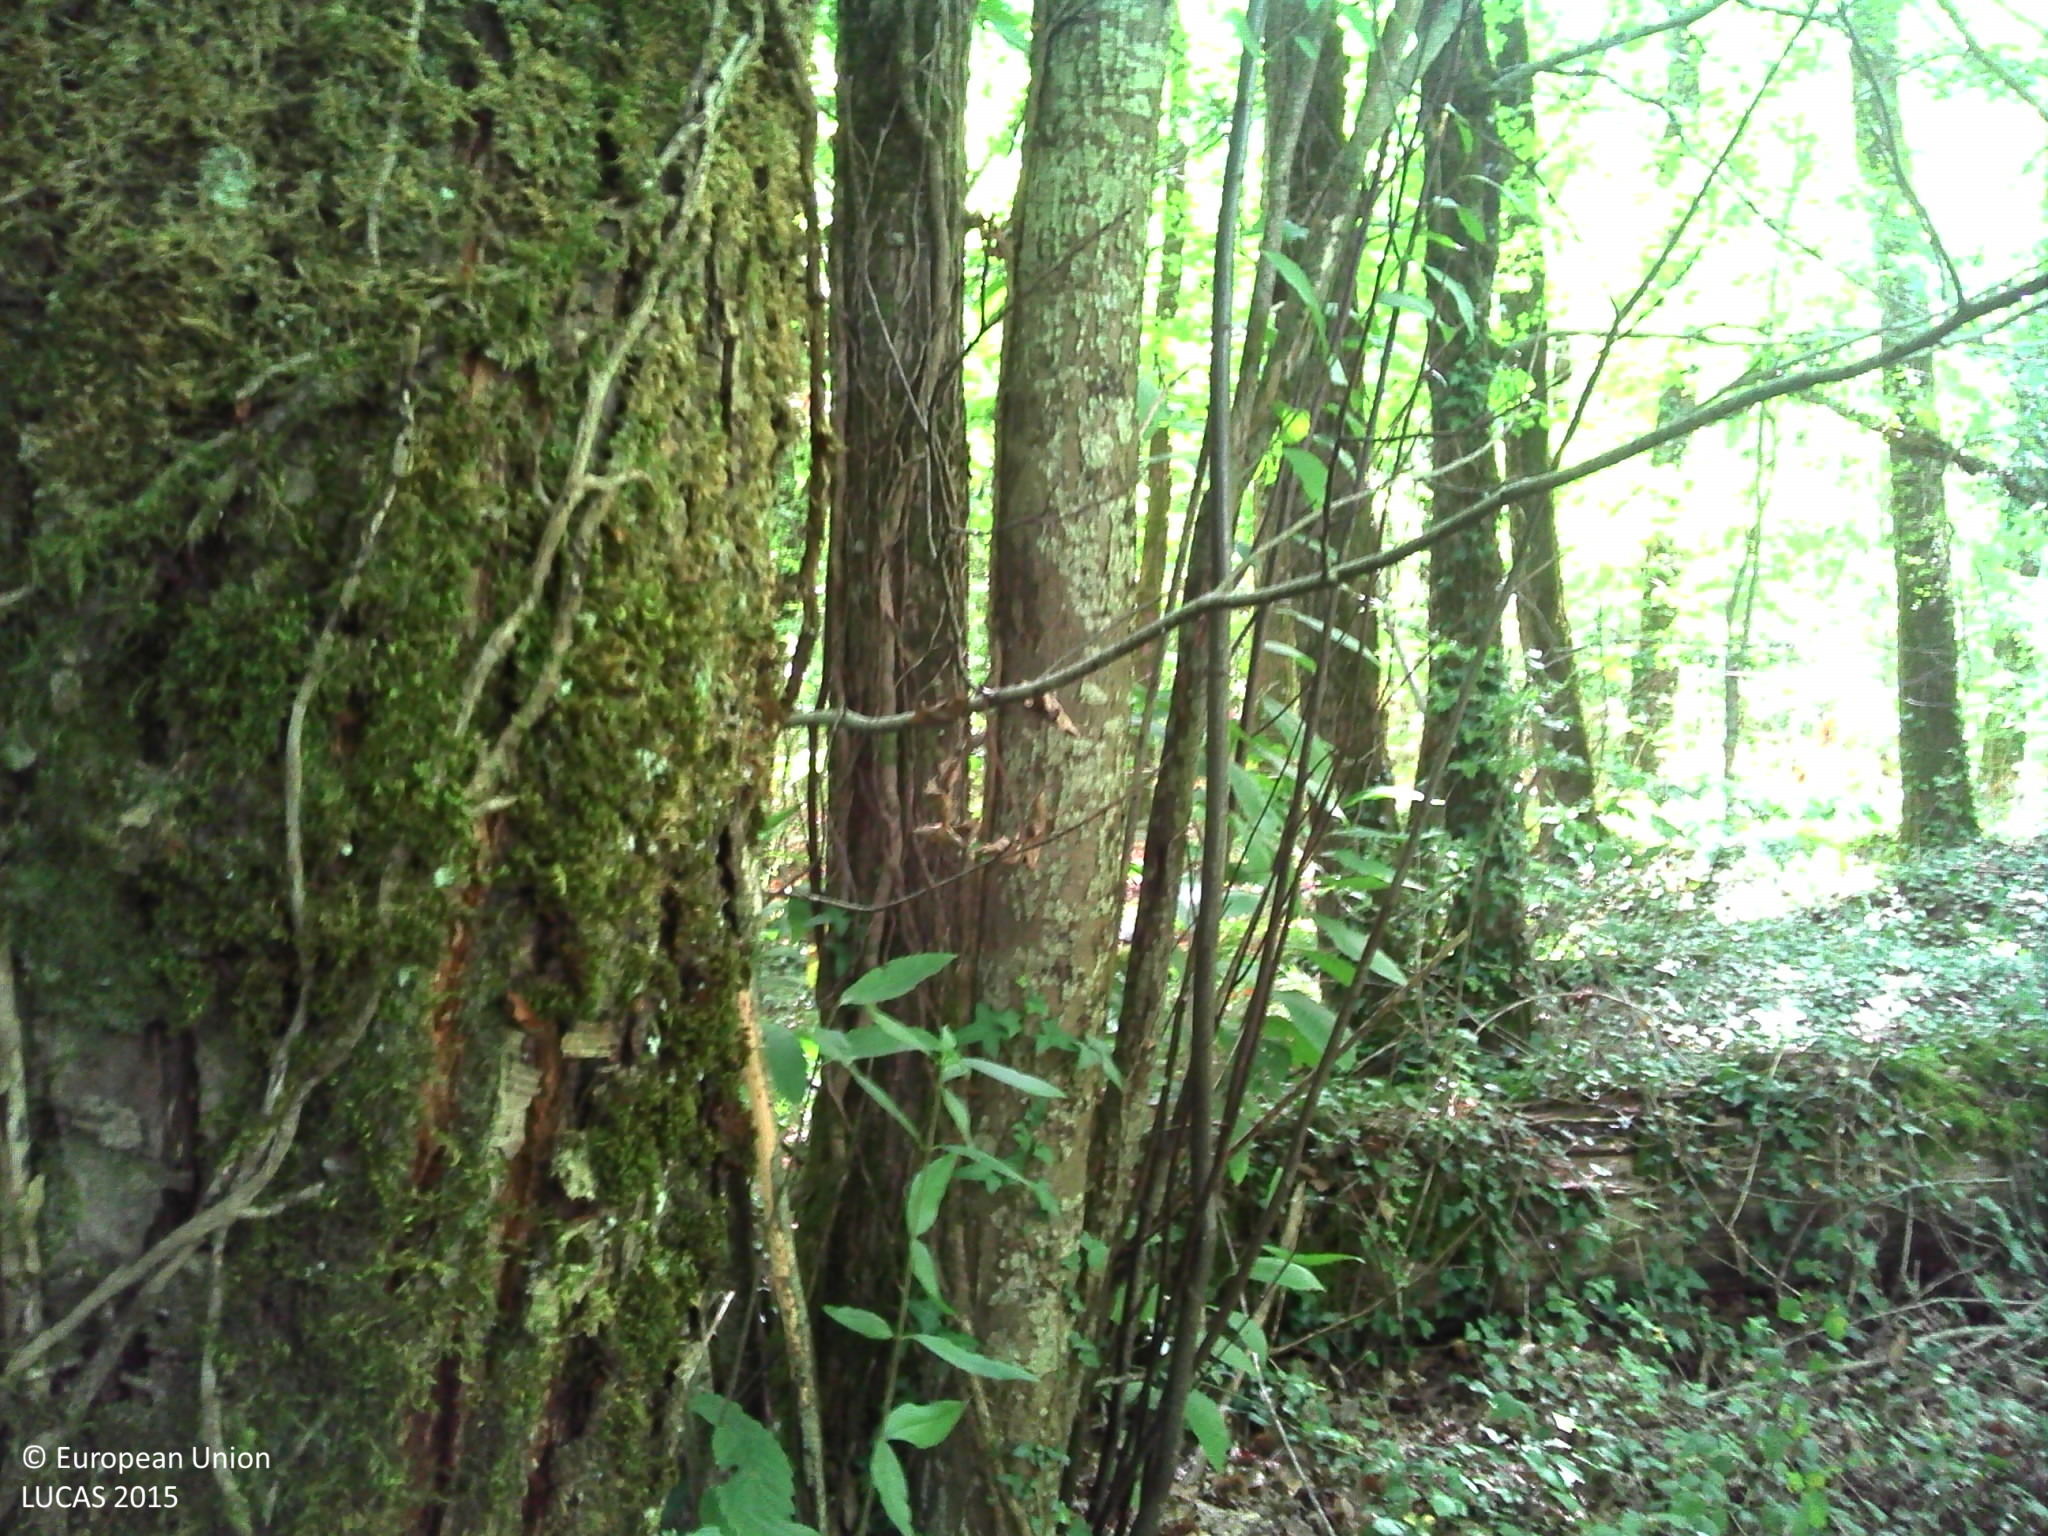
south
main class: Woodland
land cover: Broadleaved woodland
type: thermophilous deciduous forest
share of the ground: > 75 %
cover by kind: broadleaved forest trees 70 %, shrubs 20 %, herbaceous plants 5 %, lichens and mosses 5 %
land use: Forestry
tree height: > 5 m
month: August
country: FR
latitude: 45.3632
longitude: 0.4763
